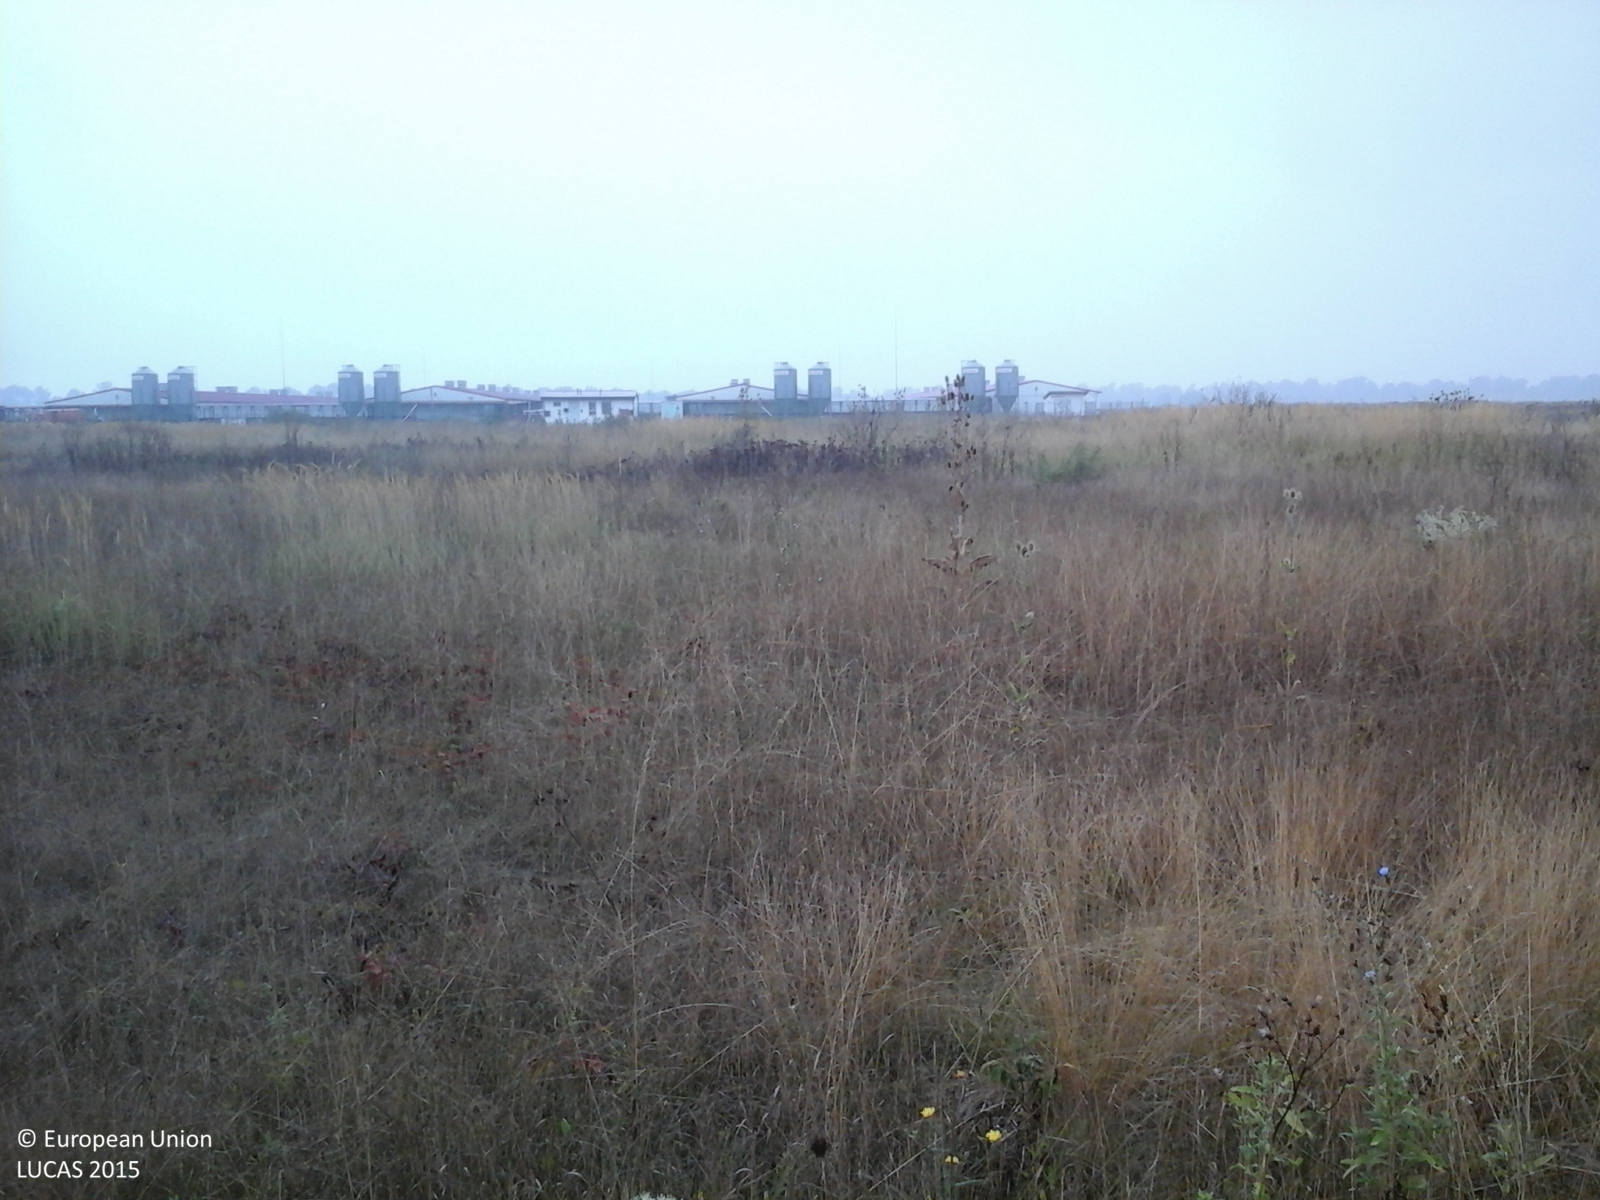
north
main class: Grassland
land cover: Spontaneously vegetated surfaces
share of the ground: > 75 %
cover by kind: herbaceous plants 100 %
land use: Fallow land
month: August
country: RO
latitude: 46.0701
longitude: 20.8495
